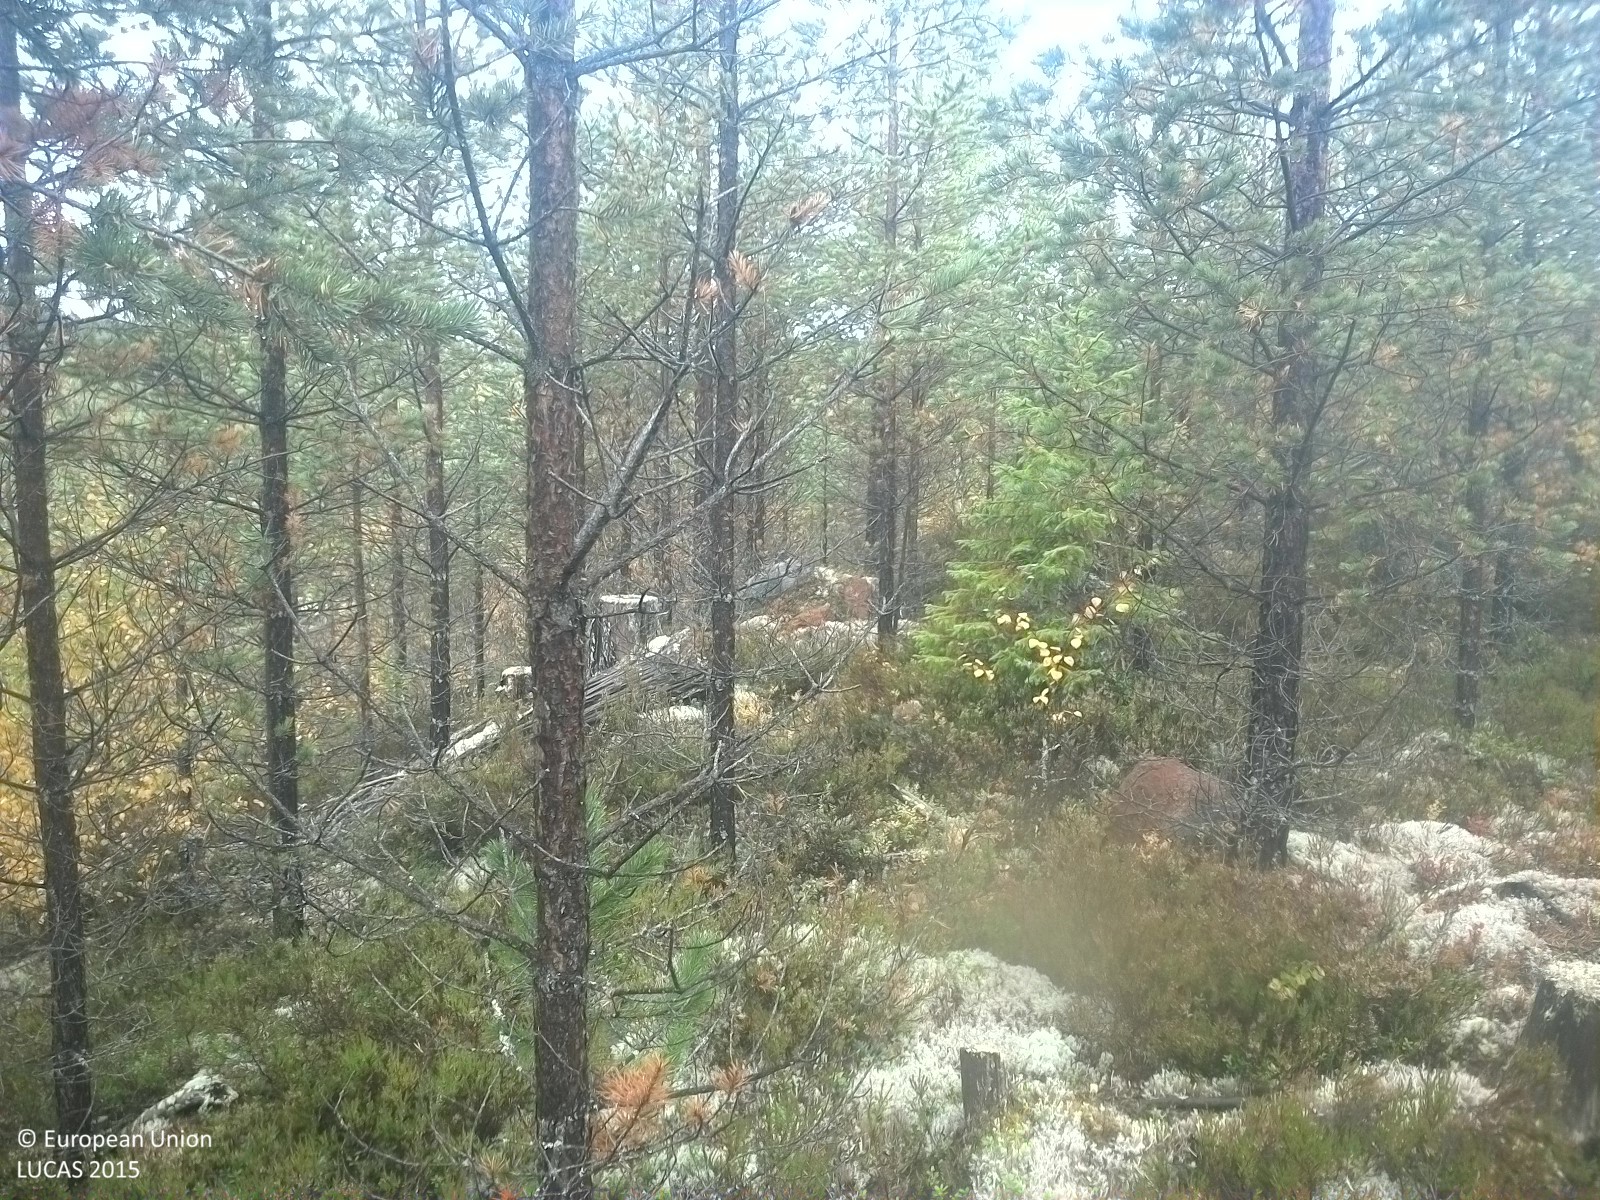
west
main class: Woodland
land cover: Pine dominated coniferous woodland
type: boreal forest
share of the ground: 25 - 50 %
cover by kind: shrubs 40 %, coniferous forest trees 35 %, lichens and mosses 20 %, broadleaved forest trees 5 %
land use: Forestry
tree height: > 5 m
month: September
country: SE
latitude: 62.1466
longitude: 15.6027
